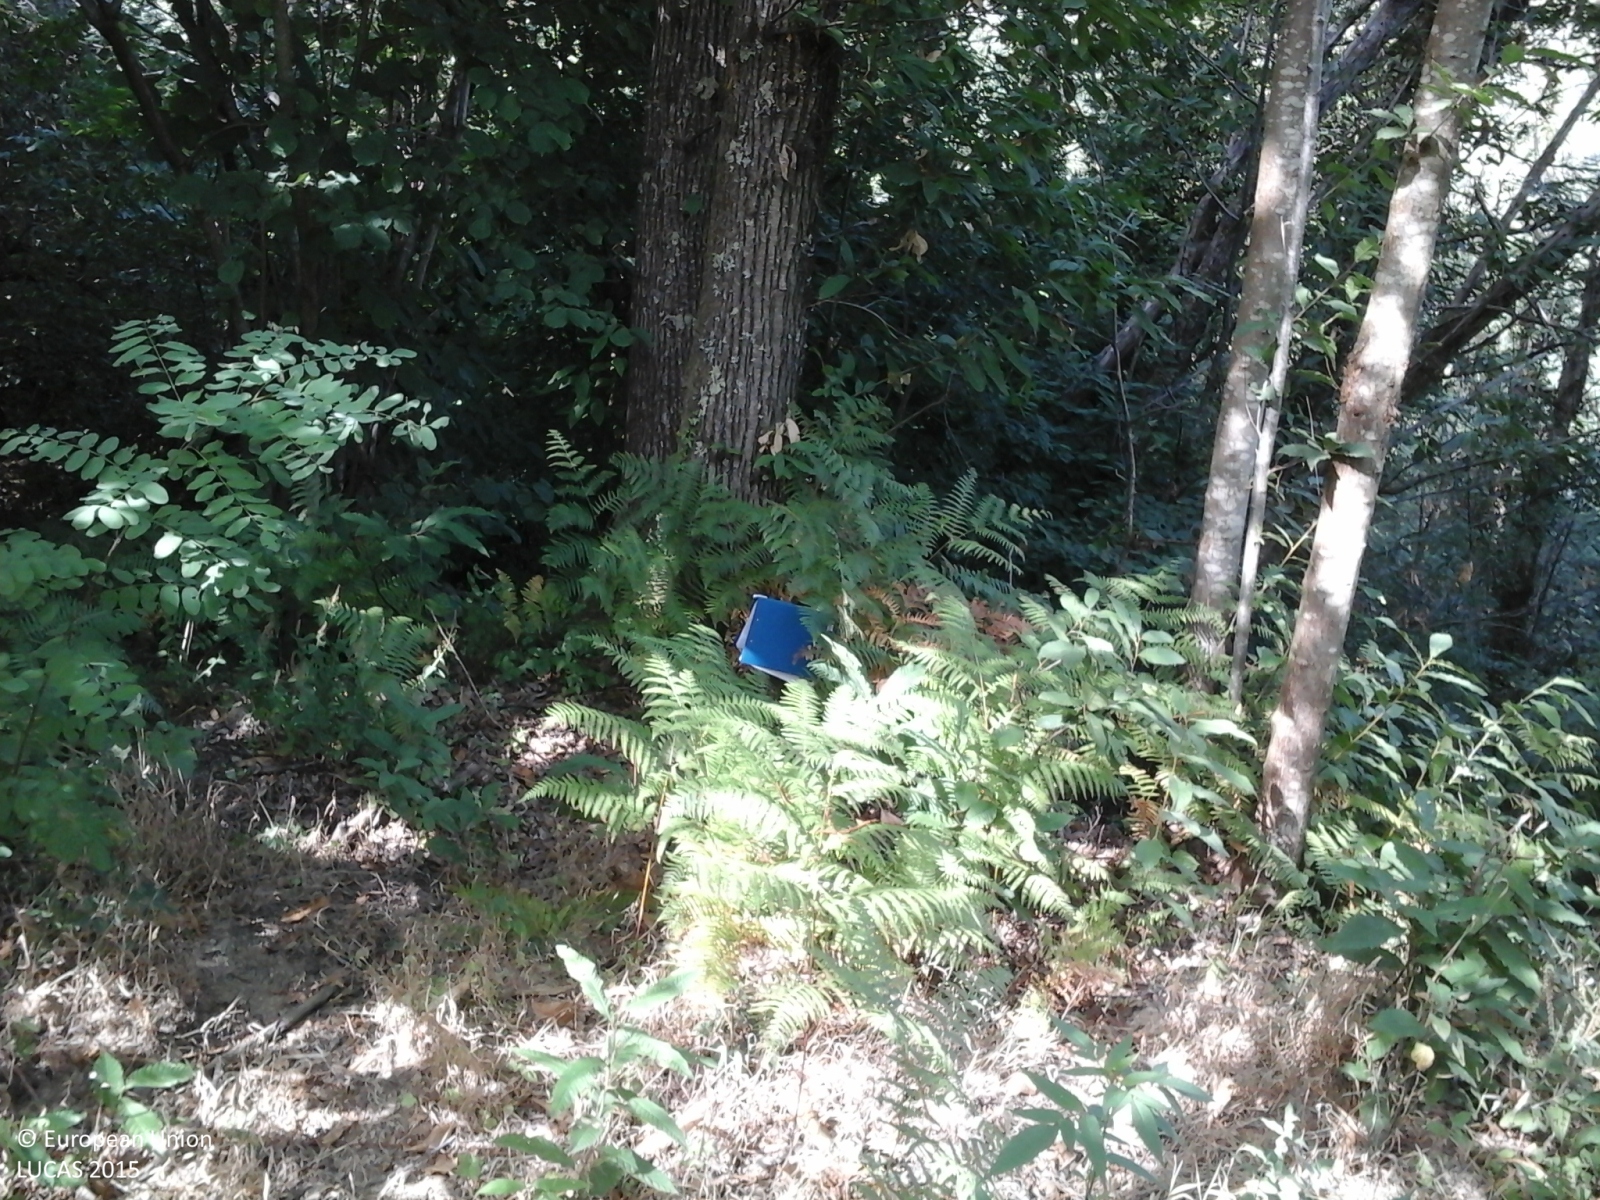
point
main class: Woodland
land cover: Broadleaved woodland
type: mesophytic deciduous forest
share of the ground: > 75 %
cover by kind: broadleaved forest trees 85 %, herbaceous plants 10 %, shrubs 5 %
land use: Forestry
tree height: > 5 m
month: July
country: IT
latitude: 44.2062
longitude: 9.8627
